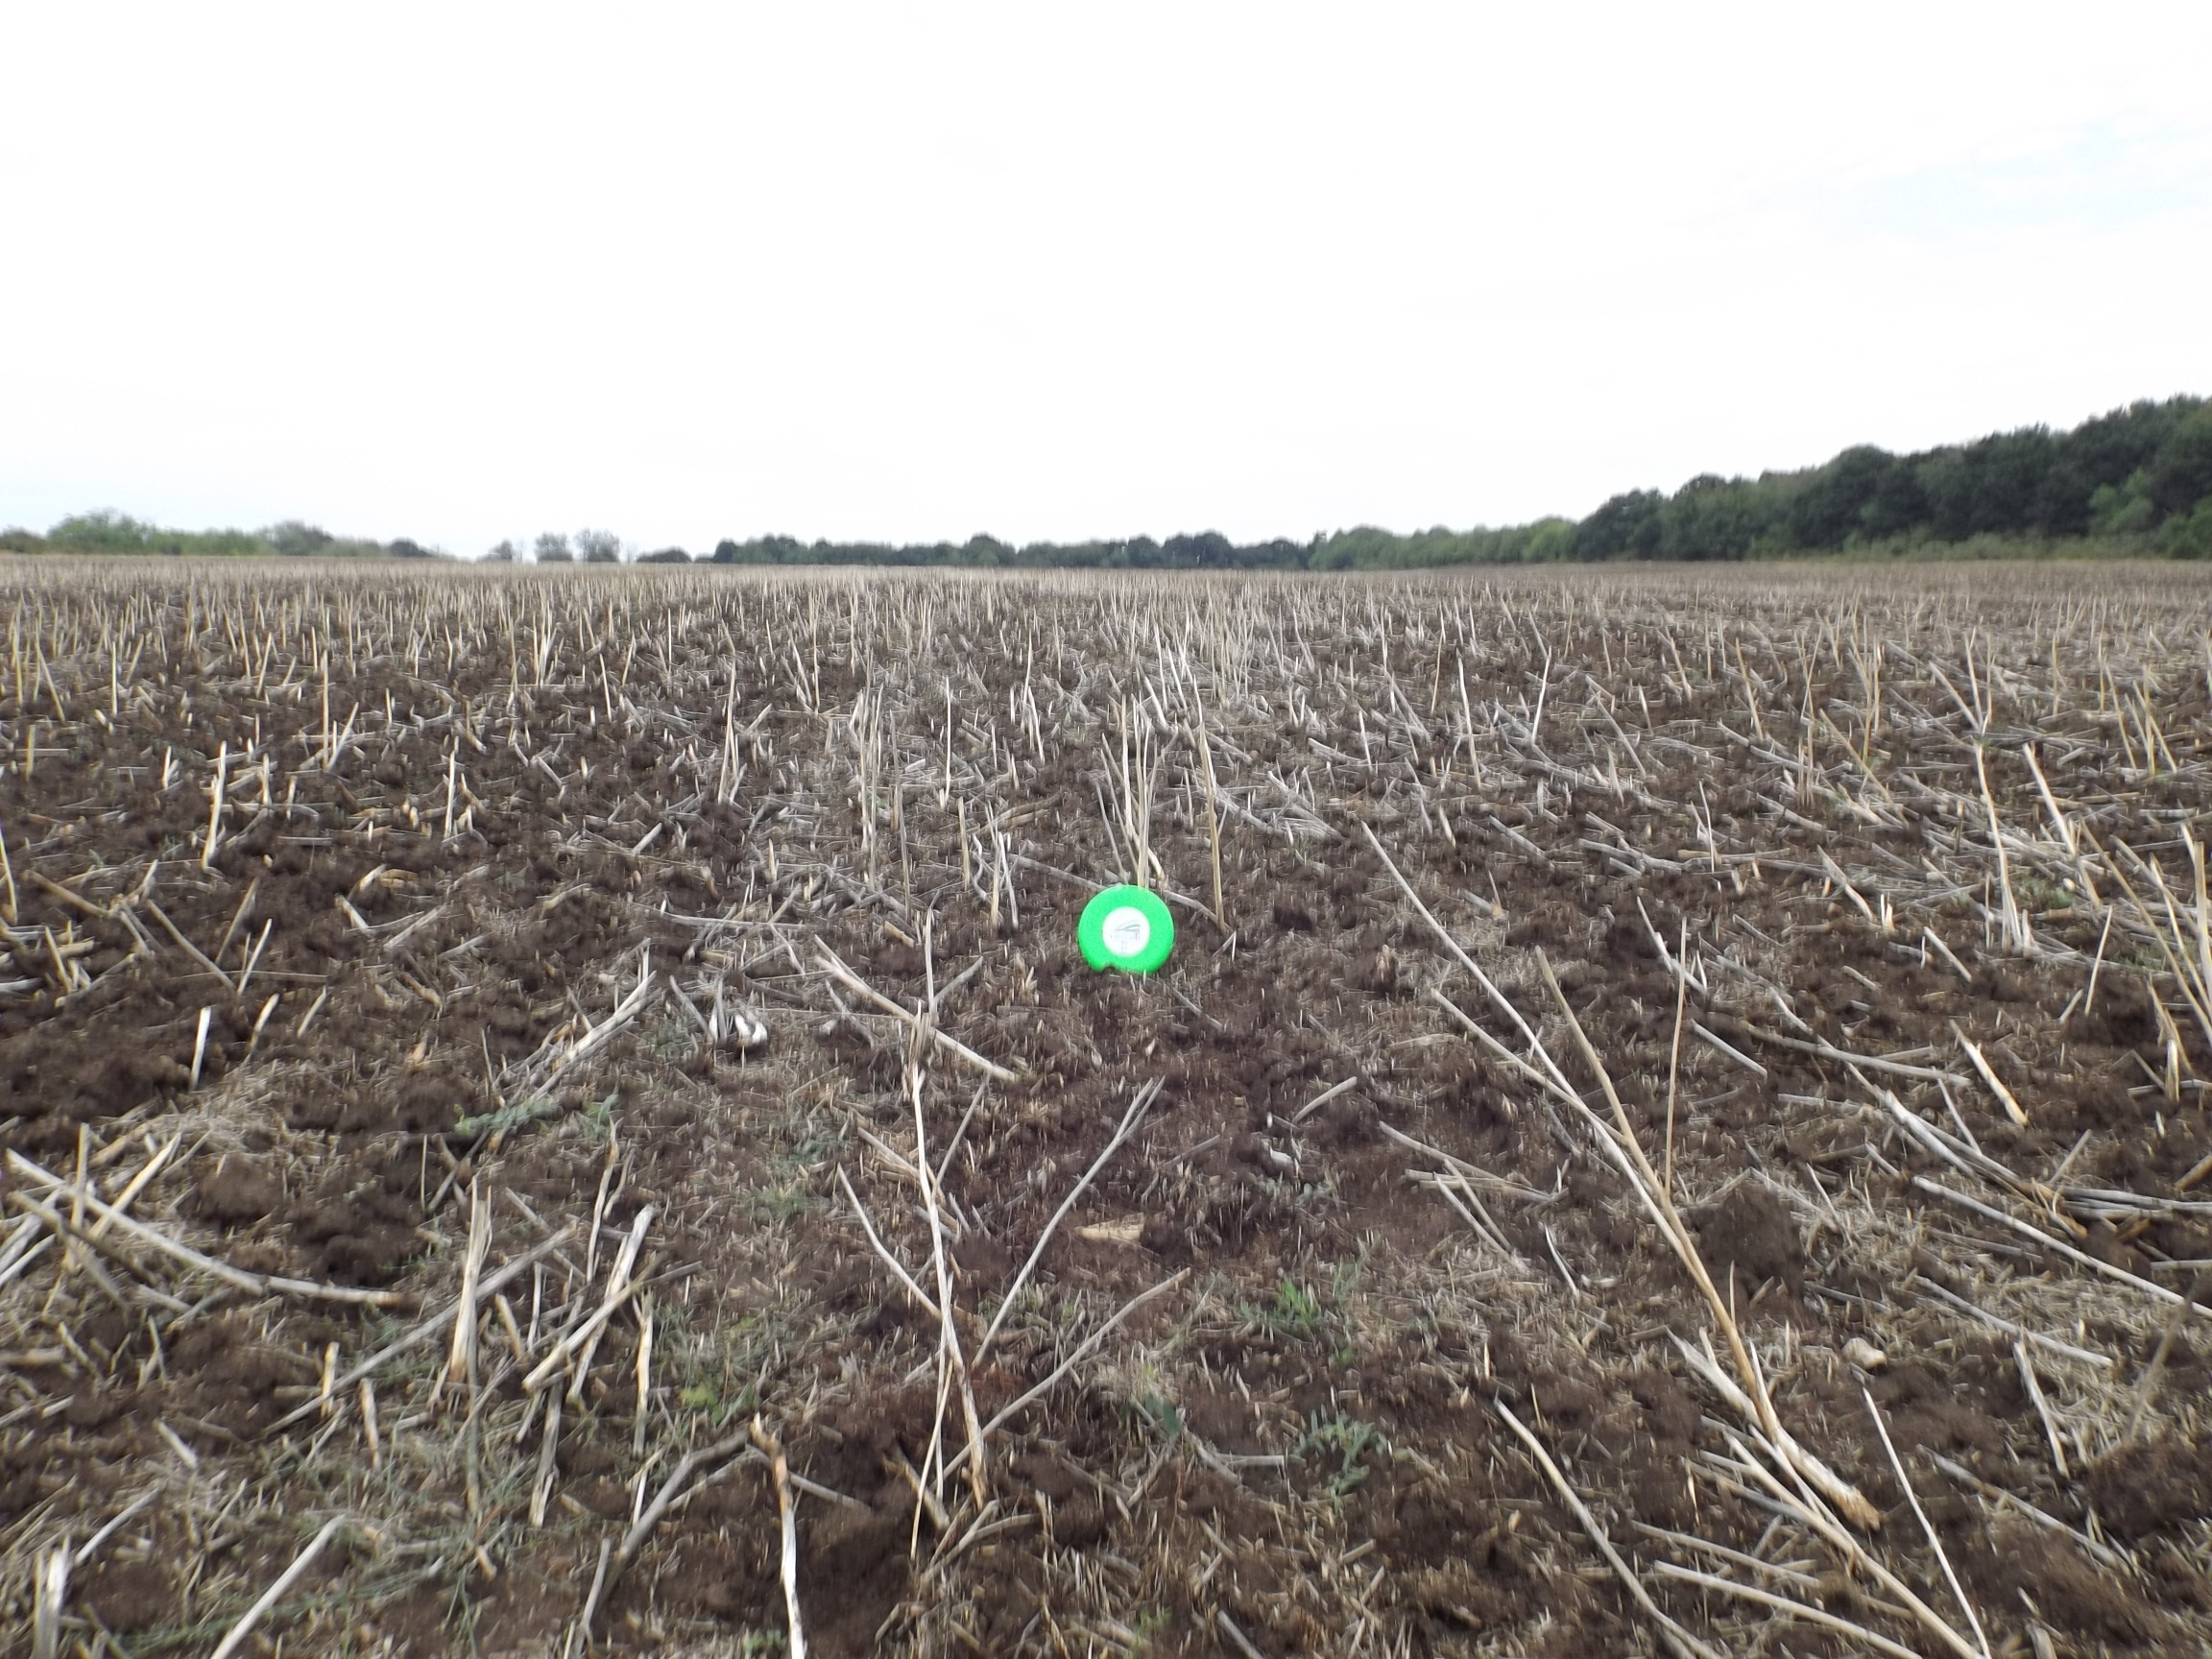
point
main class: Cropland
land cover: Maize
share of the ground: < 10 %
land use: Agriculture (excluding fallow land and kitchen gardens)
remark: Harvested field
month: August
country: BG
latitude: 43.1923
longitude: 27.5400
